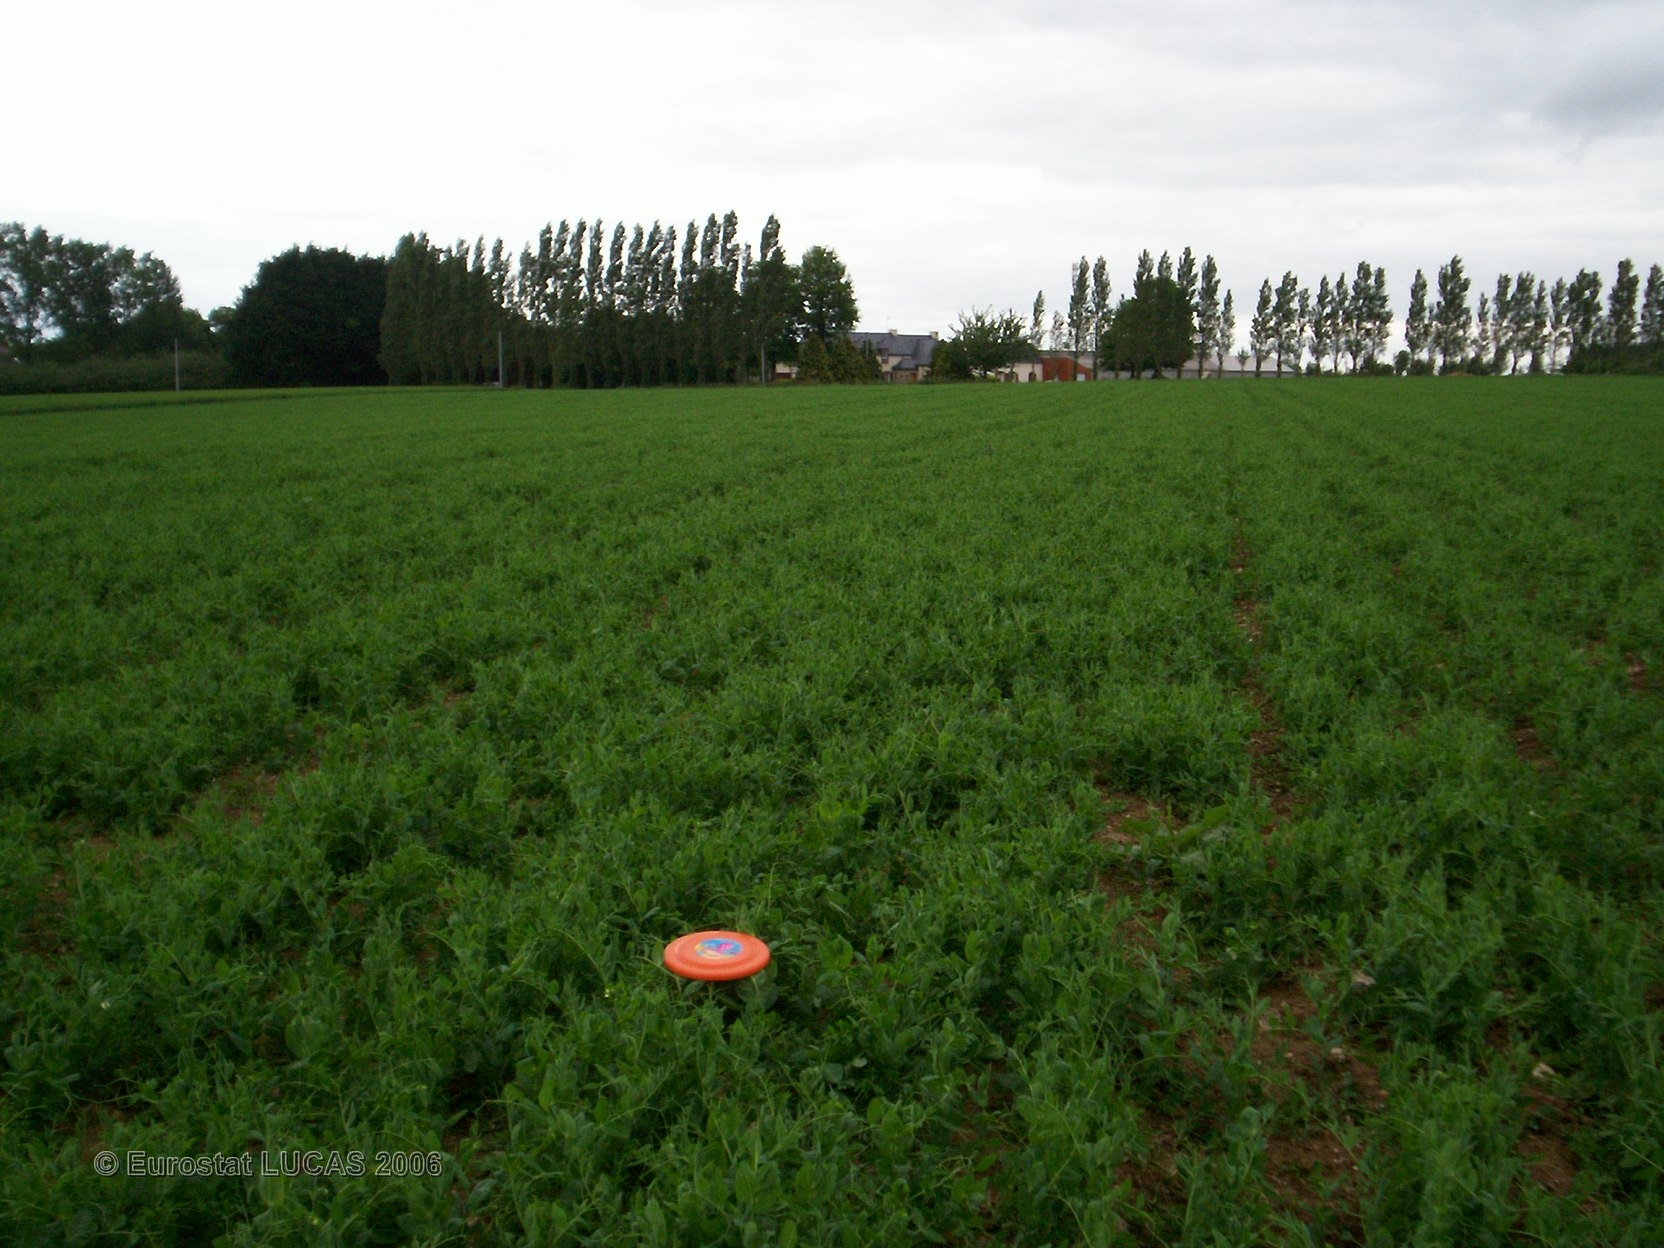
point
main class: Cropland
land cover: Dry pulses
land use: Agriculture (excluding fallow land and kitchen gardens)
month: May
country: FR
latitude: 48.1295
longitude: -2.3247
